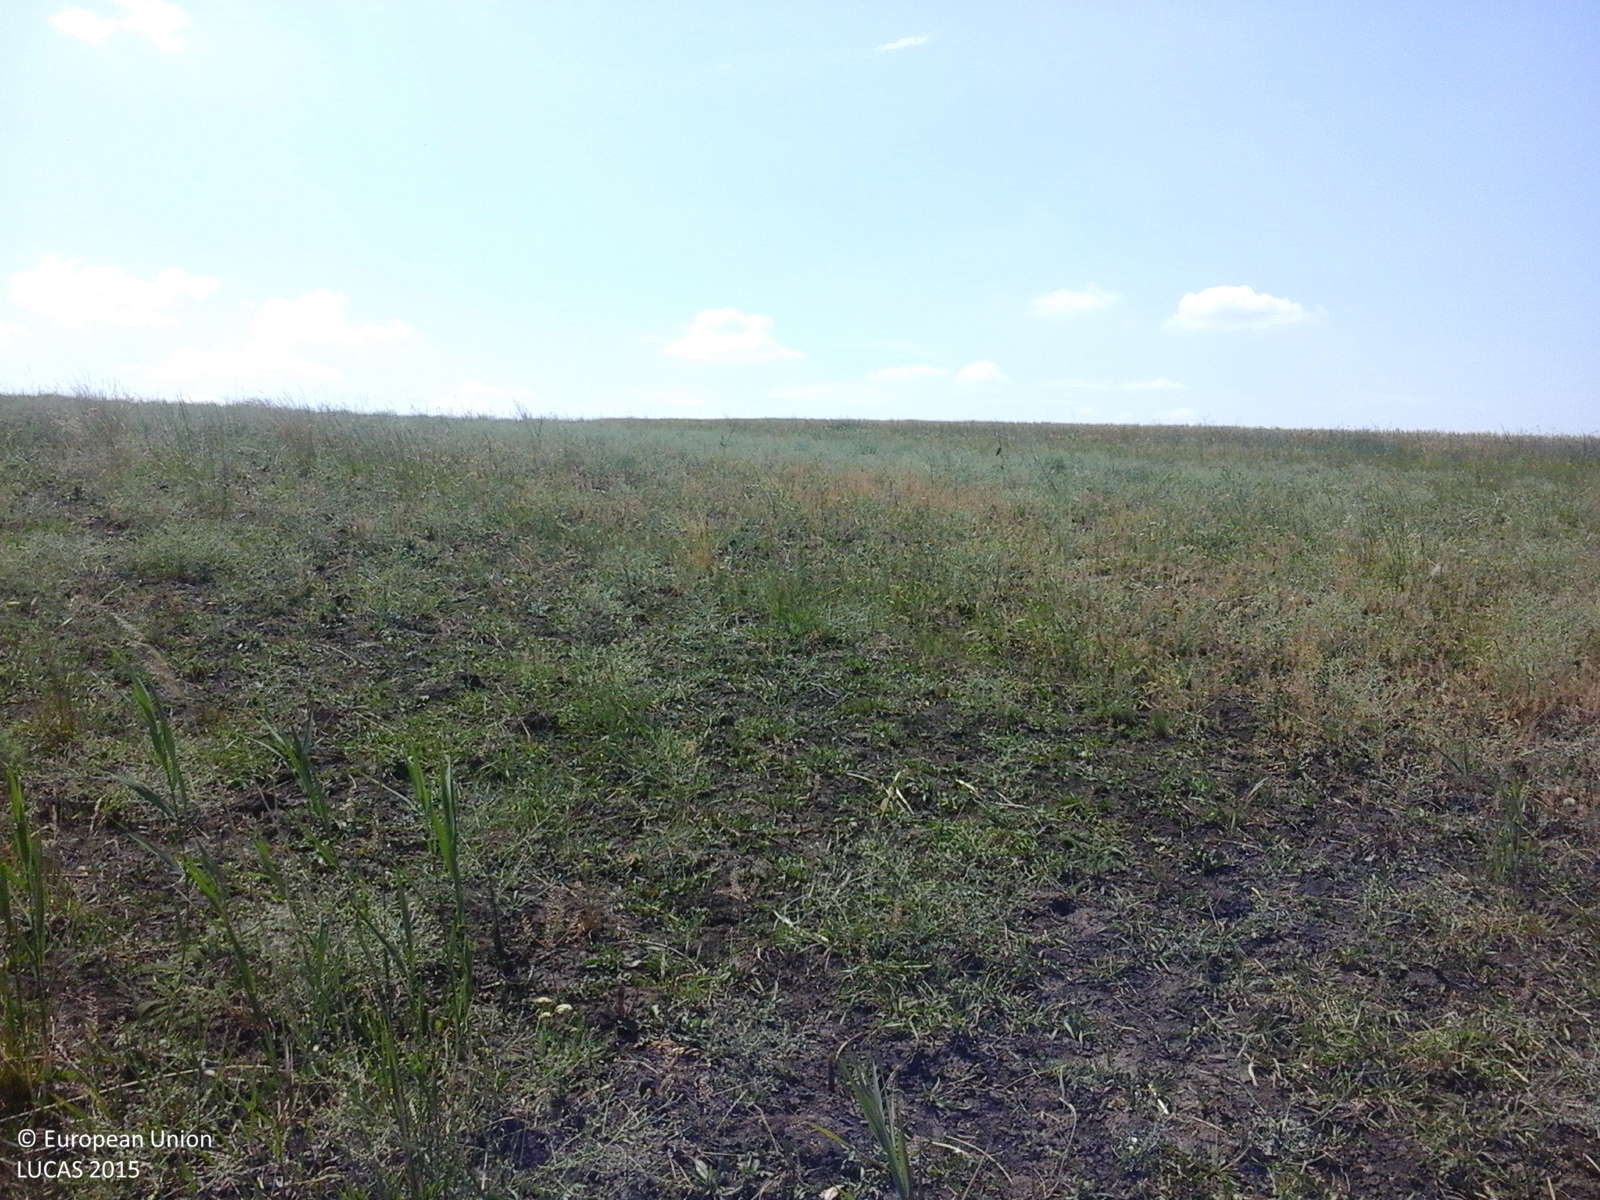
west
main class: Grassland
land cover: Spontaneously vegetated surfaces
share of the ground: > 75 %
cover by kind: herbaceous plants 100 %
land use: Fallow land
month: June
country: RO
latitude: 47.2732
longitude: 27.3626
